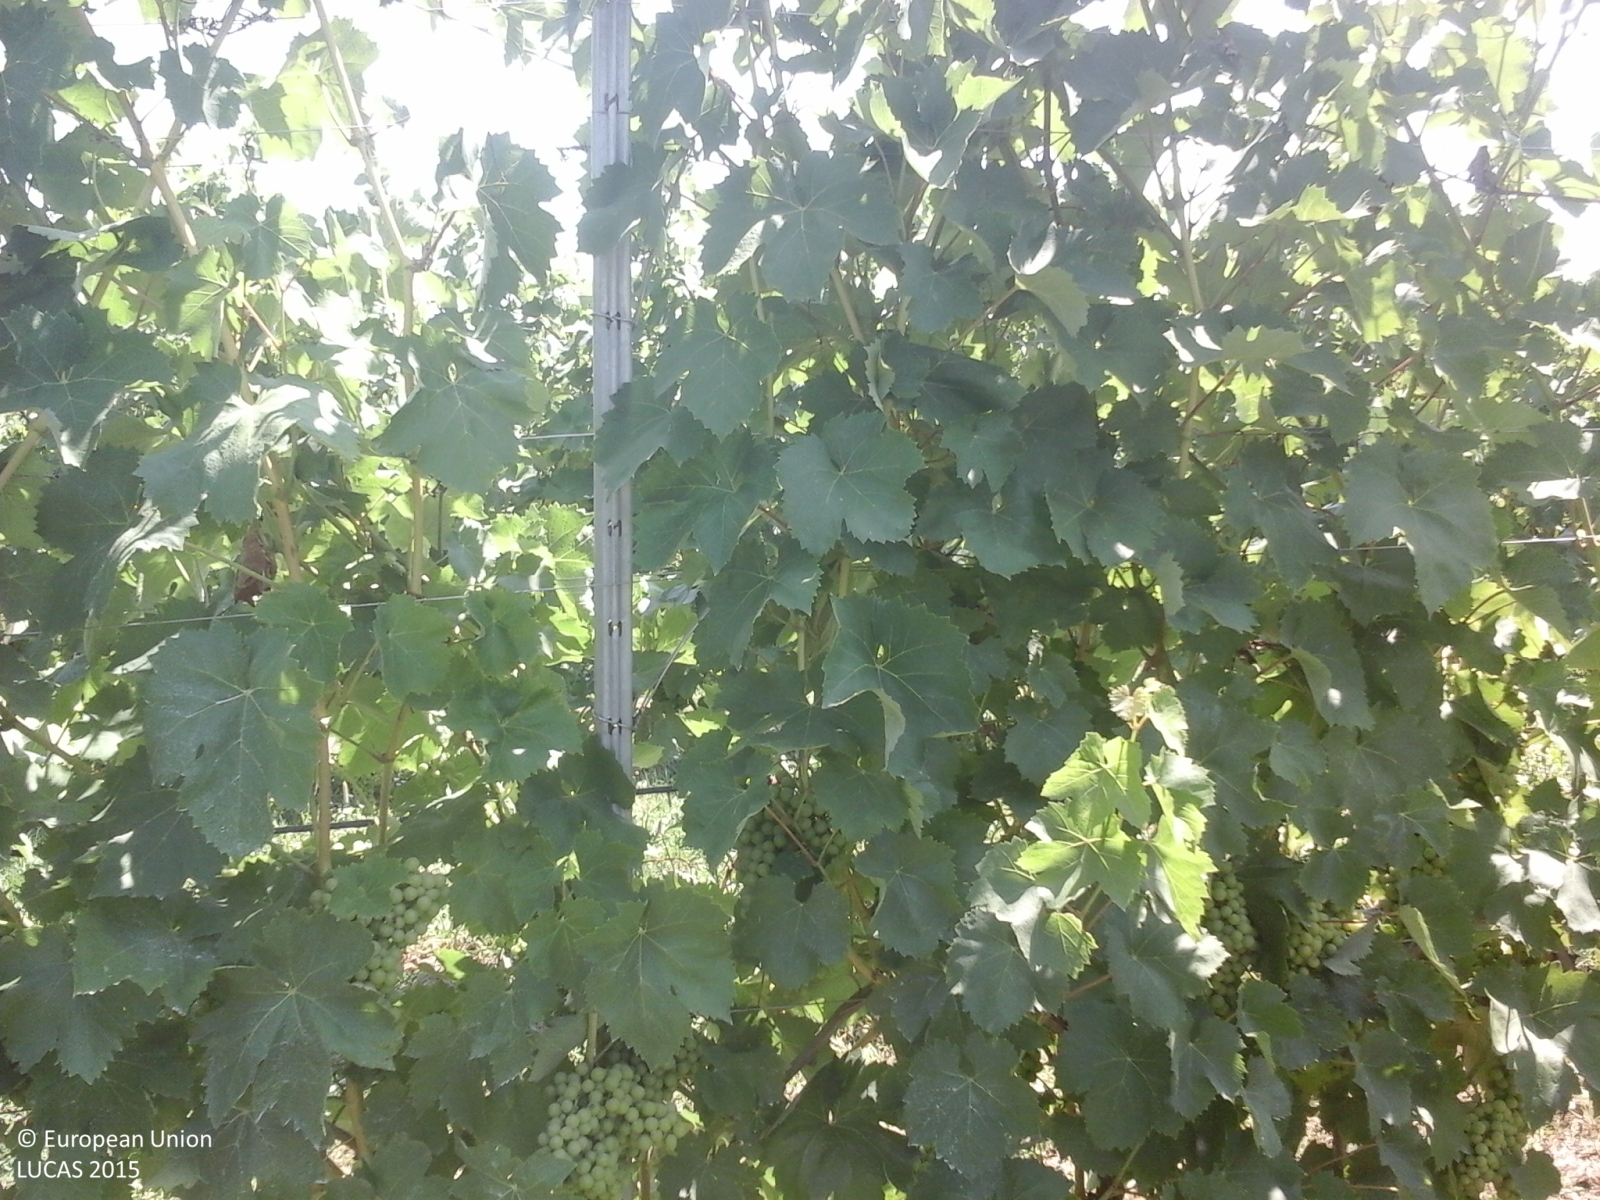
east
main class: Cropland
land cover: Vineyards
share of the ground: 25 - 50 %
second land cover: Grassland without tree/shrub cover
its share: > 75 %
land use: Agriculture (excluding fallow land and kitchen gardens)
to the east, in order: Vineyards; Grassland without tree/shrub cover; Spontaneously vegetated surfaces; Tracks; Vineyards
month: July
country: IT
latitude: 45.4485
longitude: 10.6254
